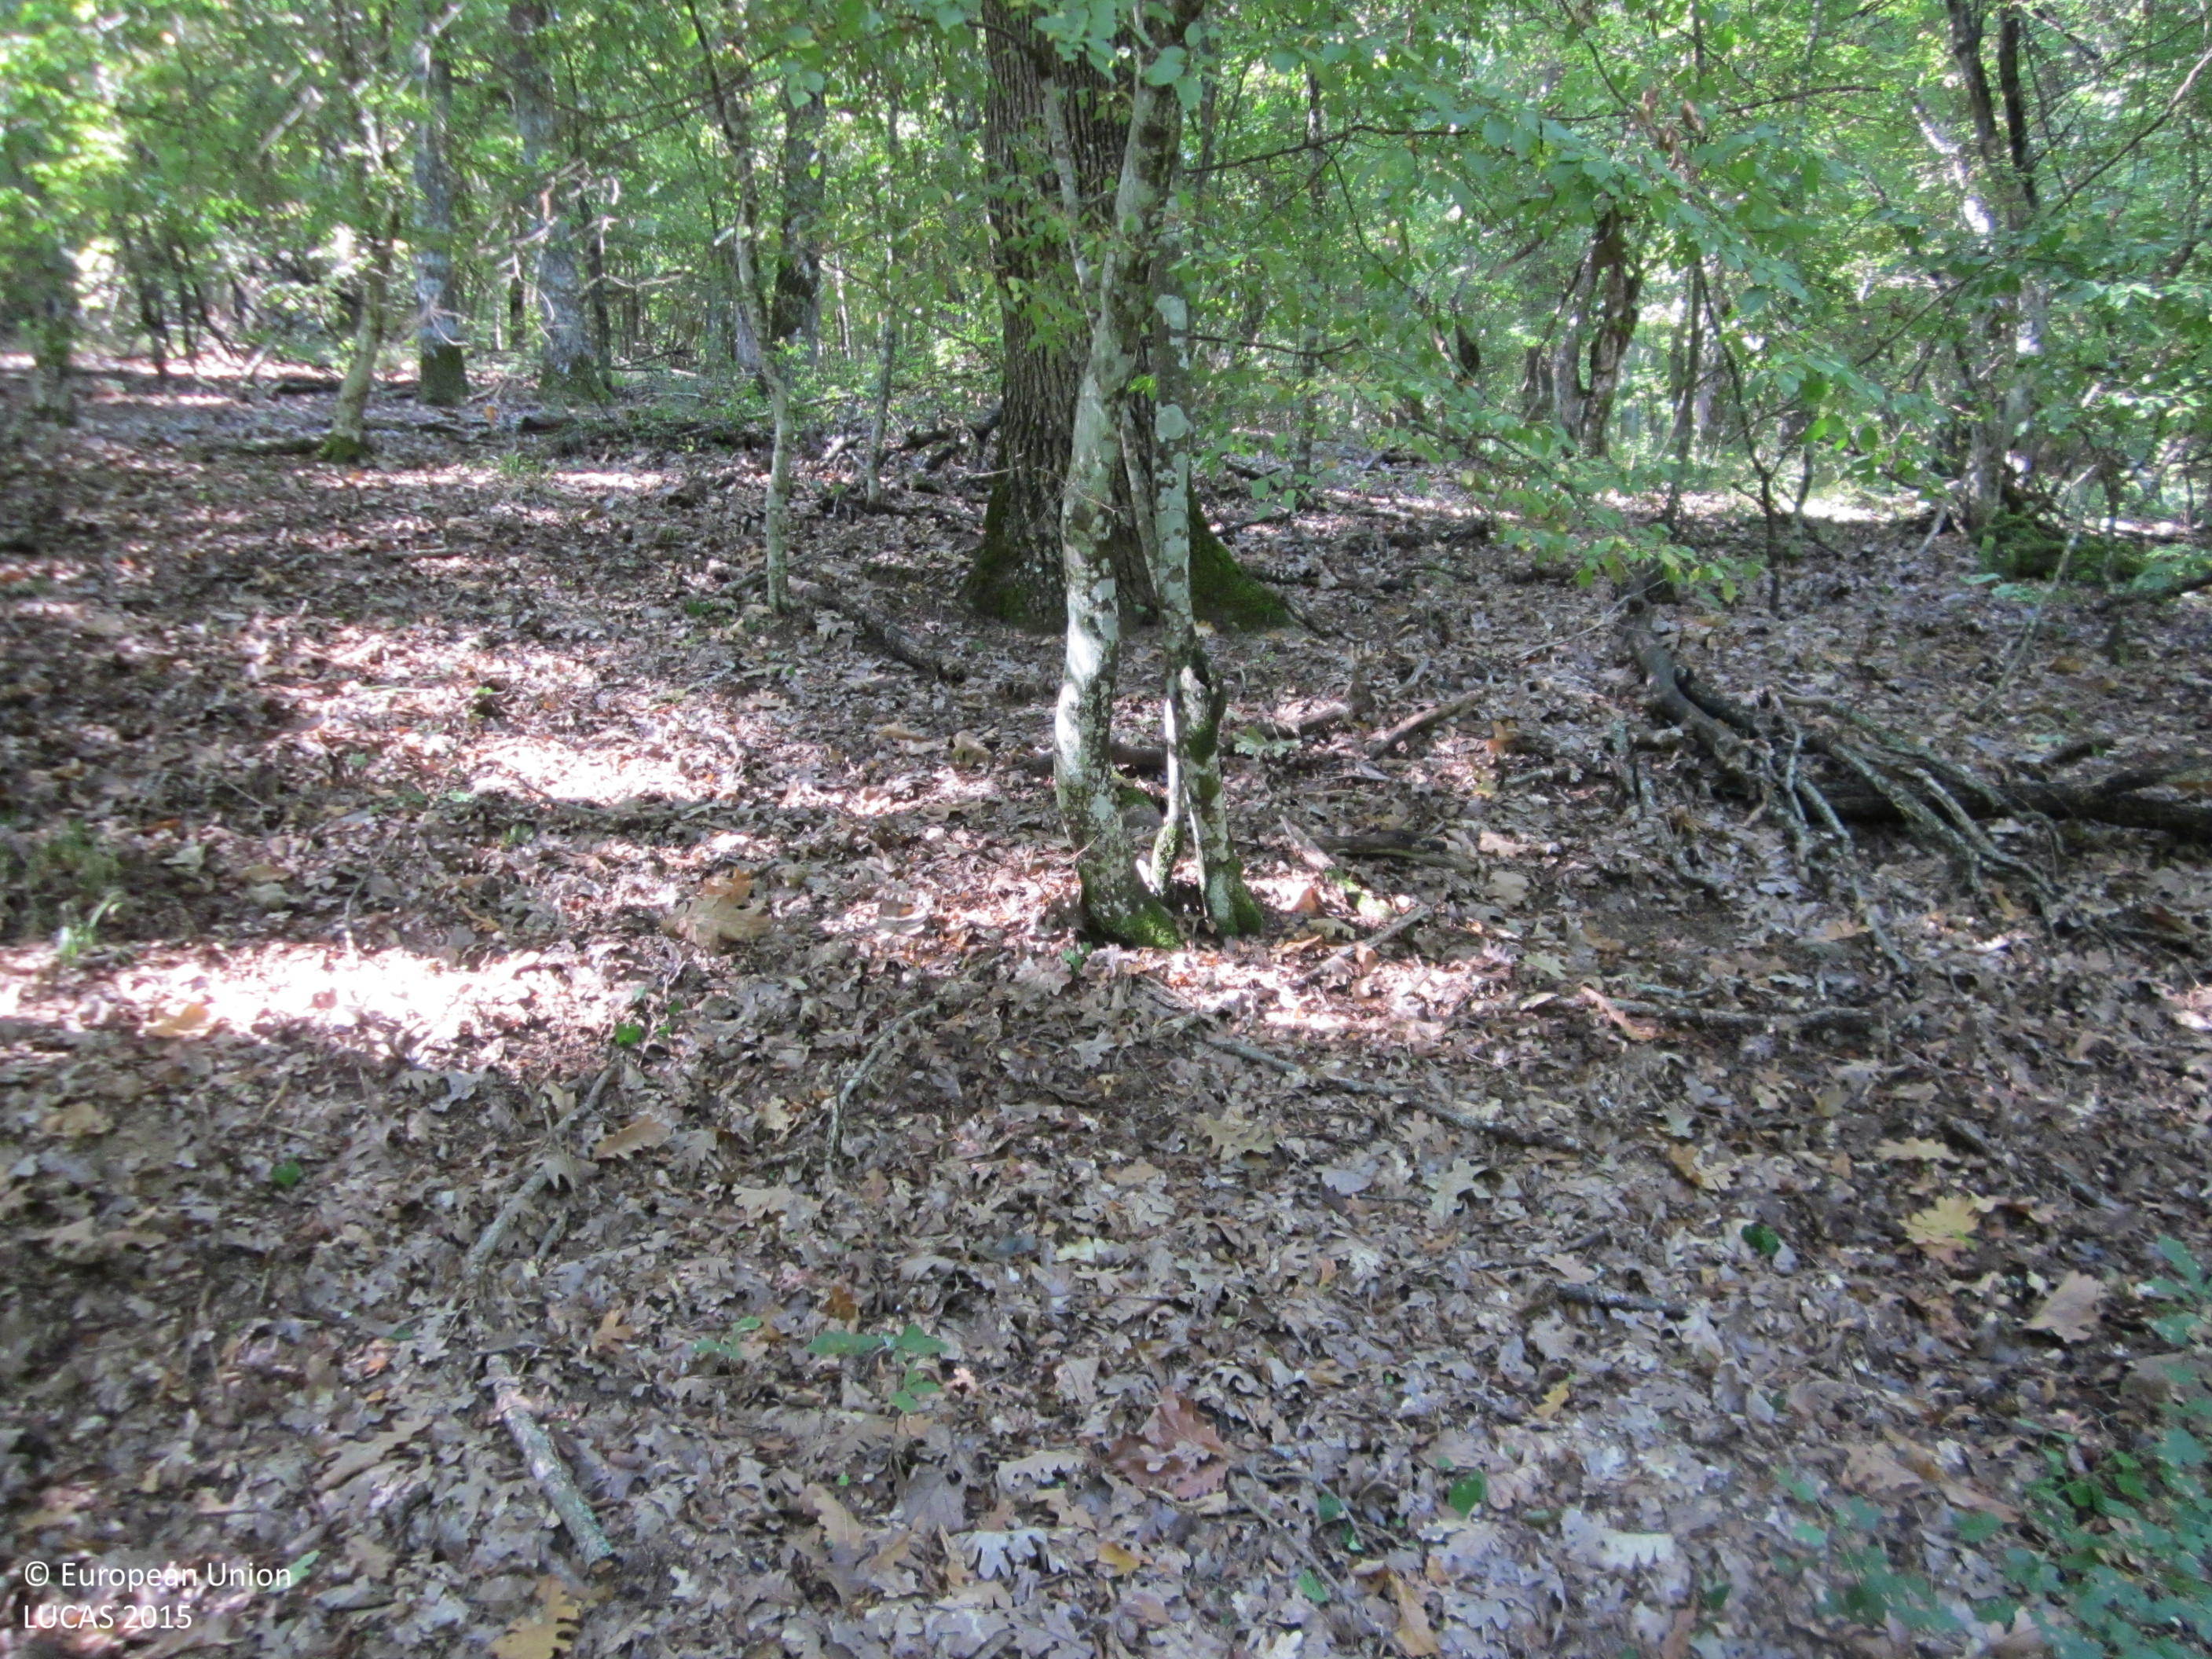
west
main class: Woodland
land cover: Broadleaved woodland
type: thermophilous deciduous forest
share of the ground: > 75 %
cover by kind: broadleaved forest trees 100 %
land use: Forestry
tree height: > 5 m
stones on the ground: < 10 %
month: September
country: BG
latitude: 42.2198
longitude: 27.1996
